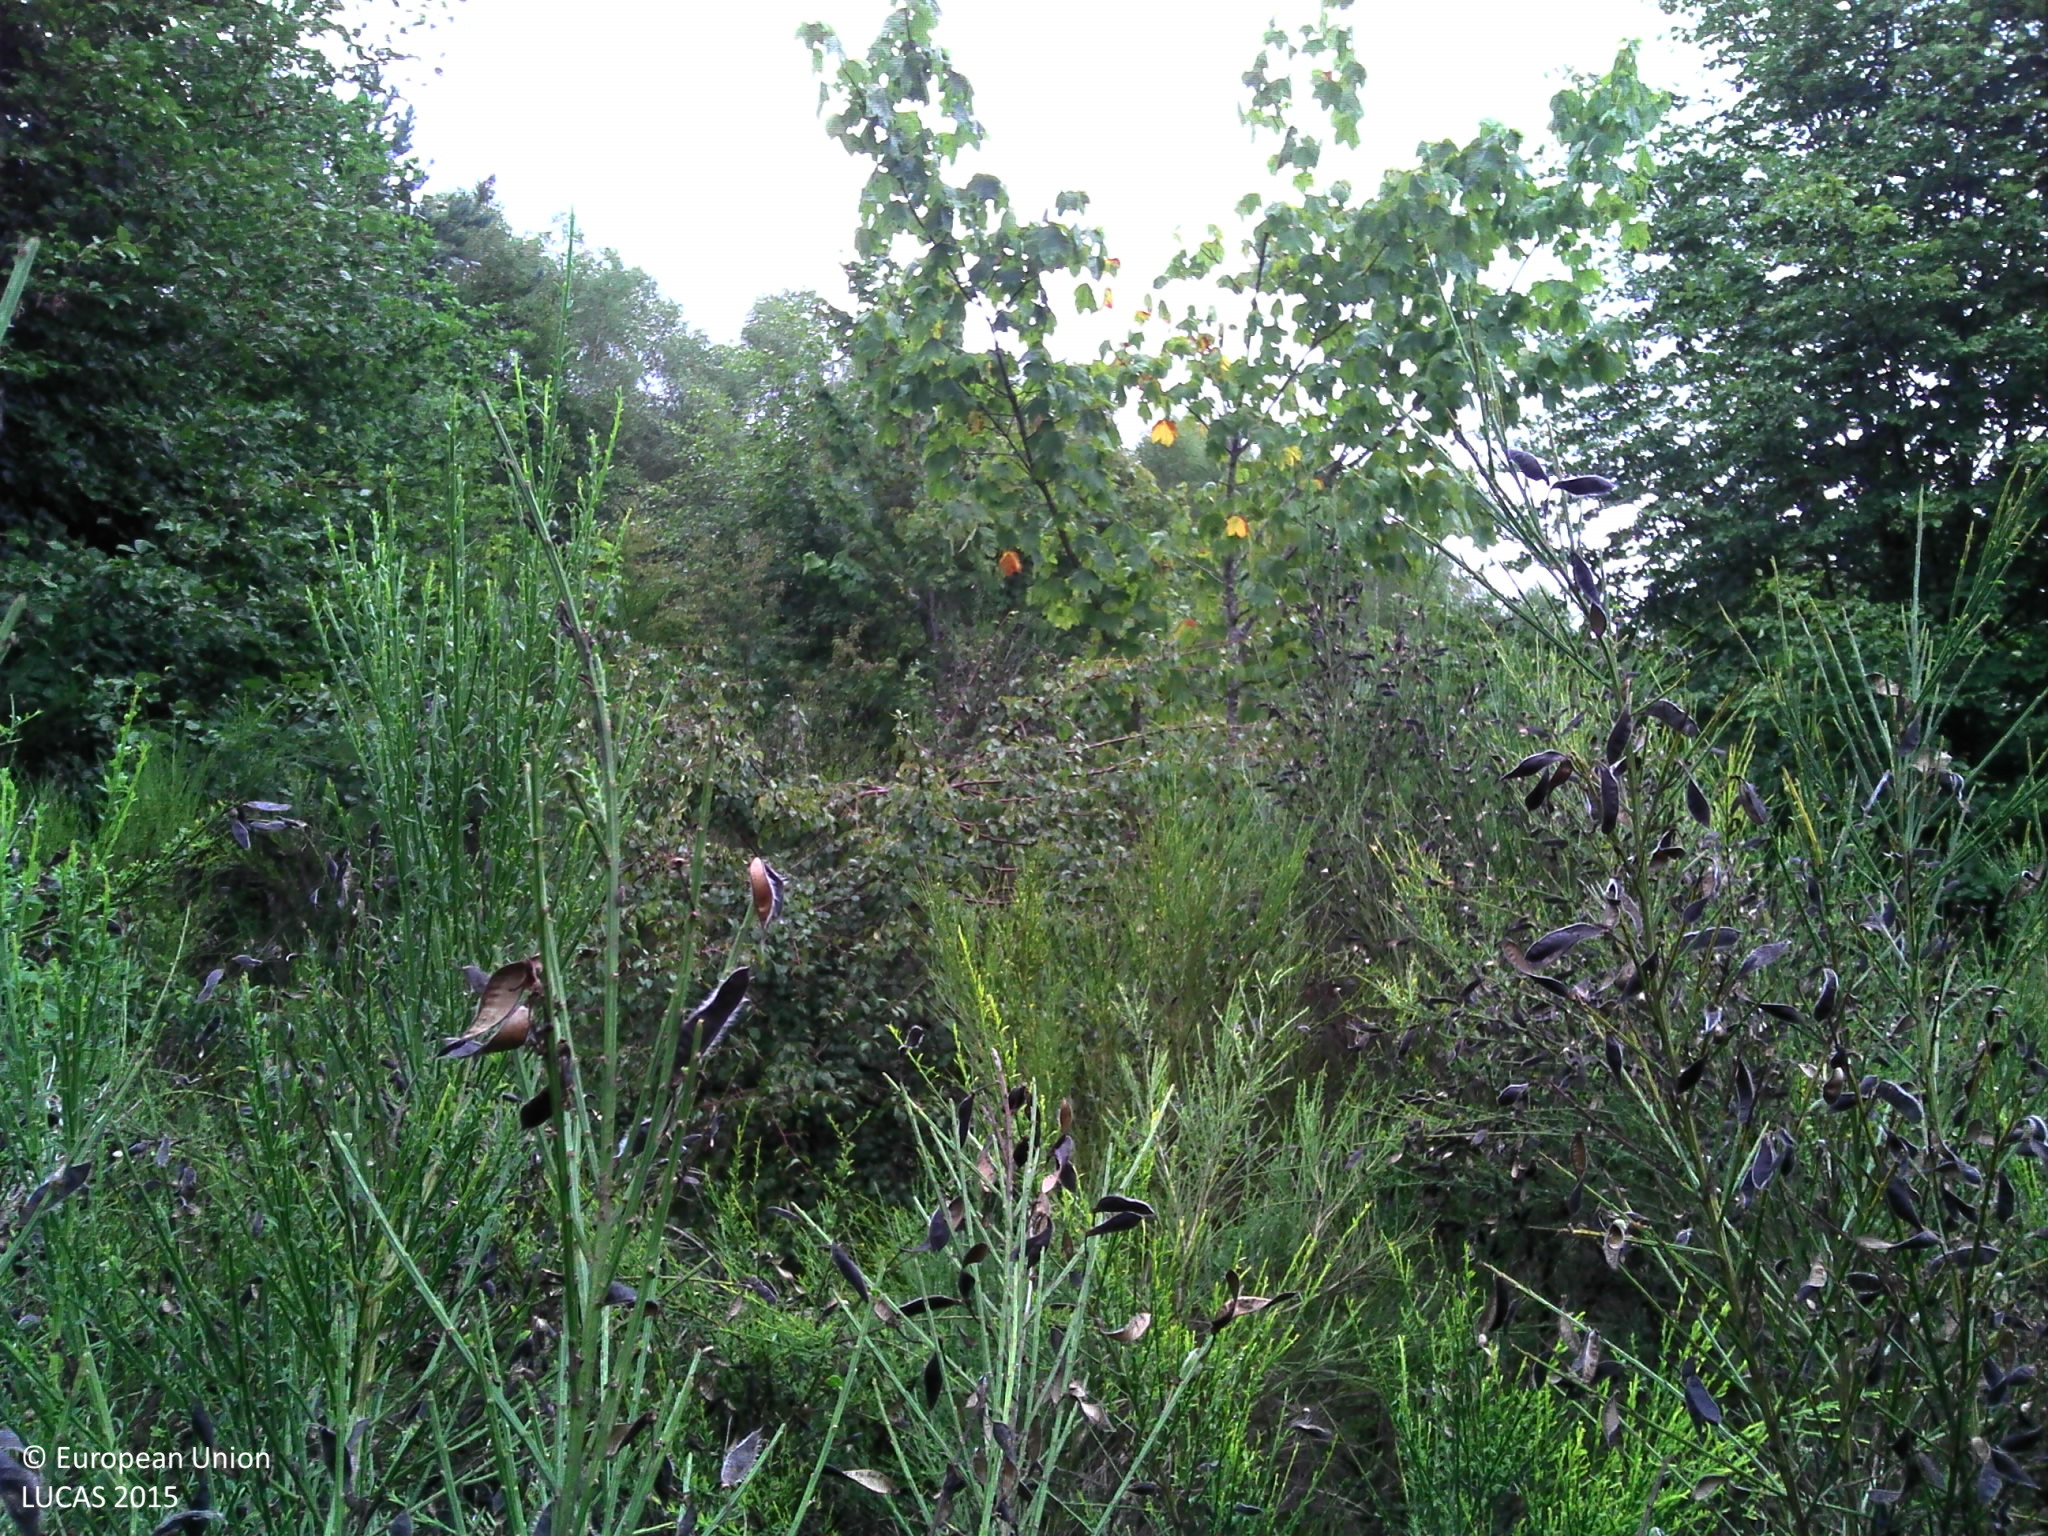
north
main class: Shrubland
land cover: Shrubland without tree cover
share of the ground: > 75 %
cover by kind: shrubs 90 %, herbaceous plants 10 %
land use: Semi-natural and natural areas not in use
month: August
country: FR
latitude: 45.4983
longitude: 1.8694
